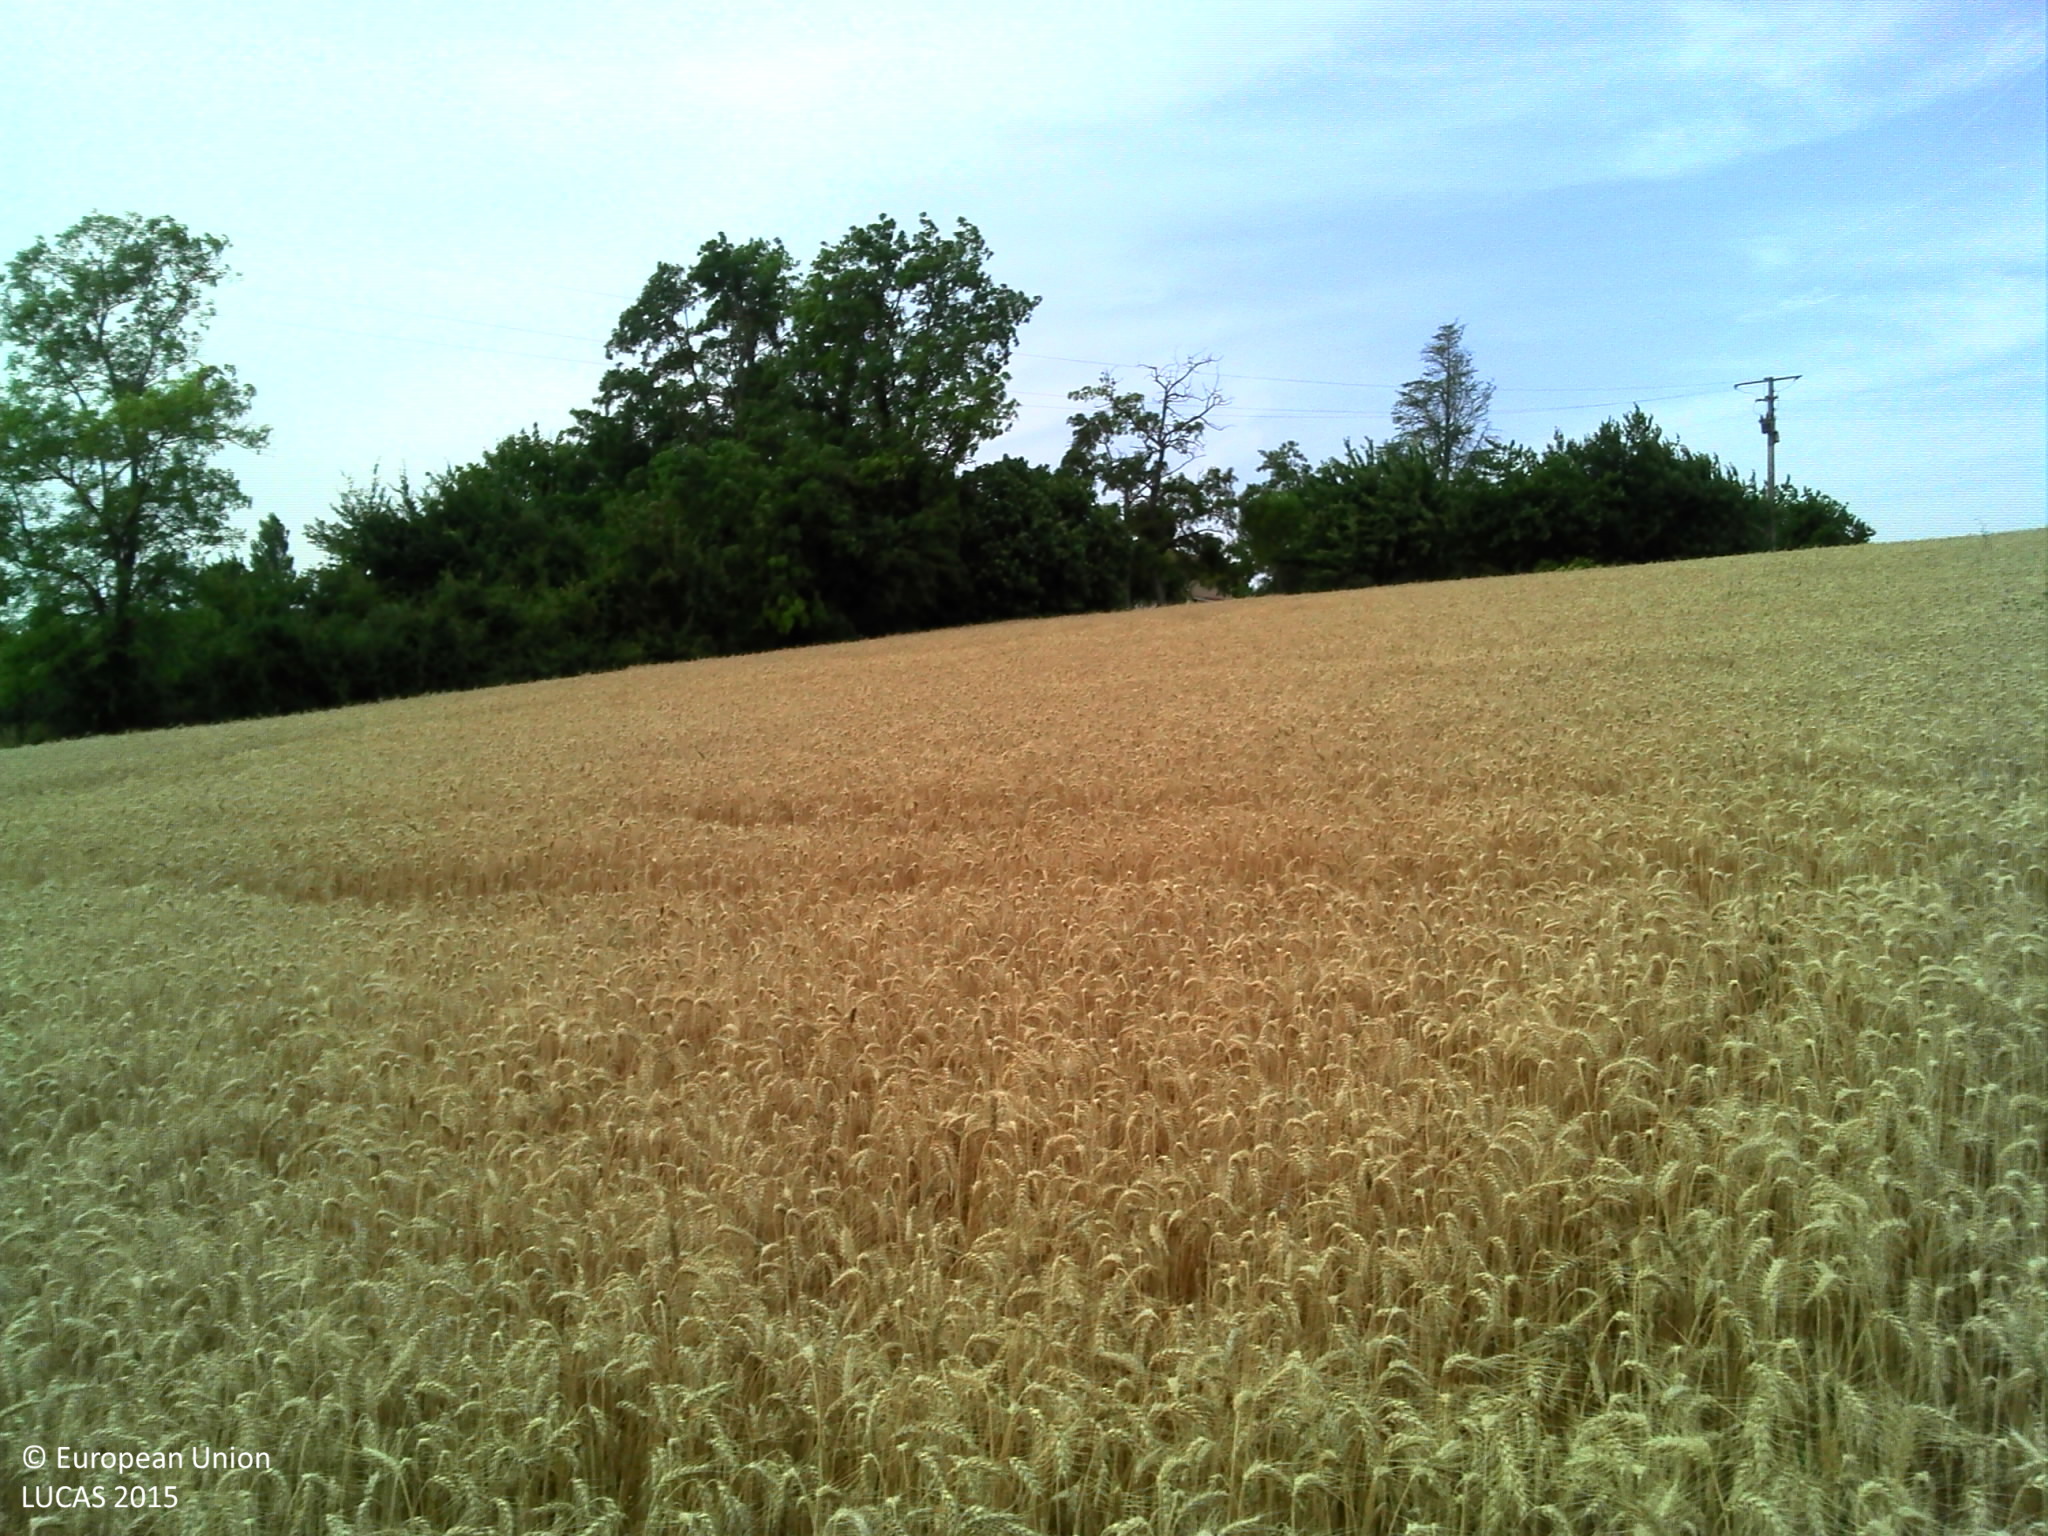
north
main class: Cropland
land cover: Durum wheat
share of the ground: > 75 %
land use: Agriculture (excluding fallow land and kitchen gardens)
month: July
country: FR
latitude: 43.5977
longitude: 1.0196
